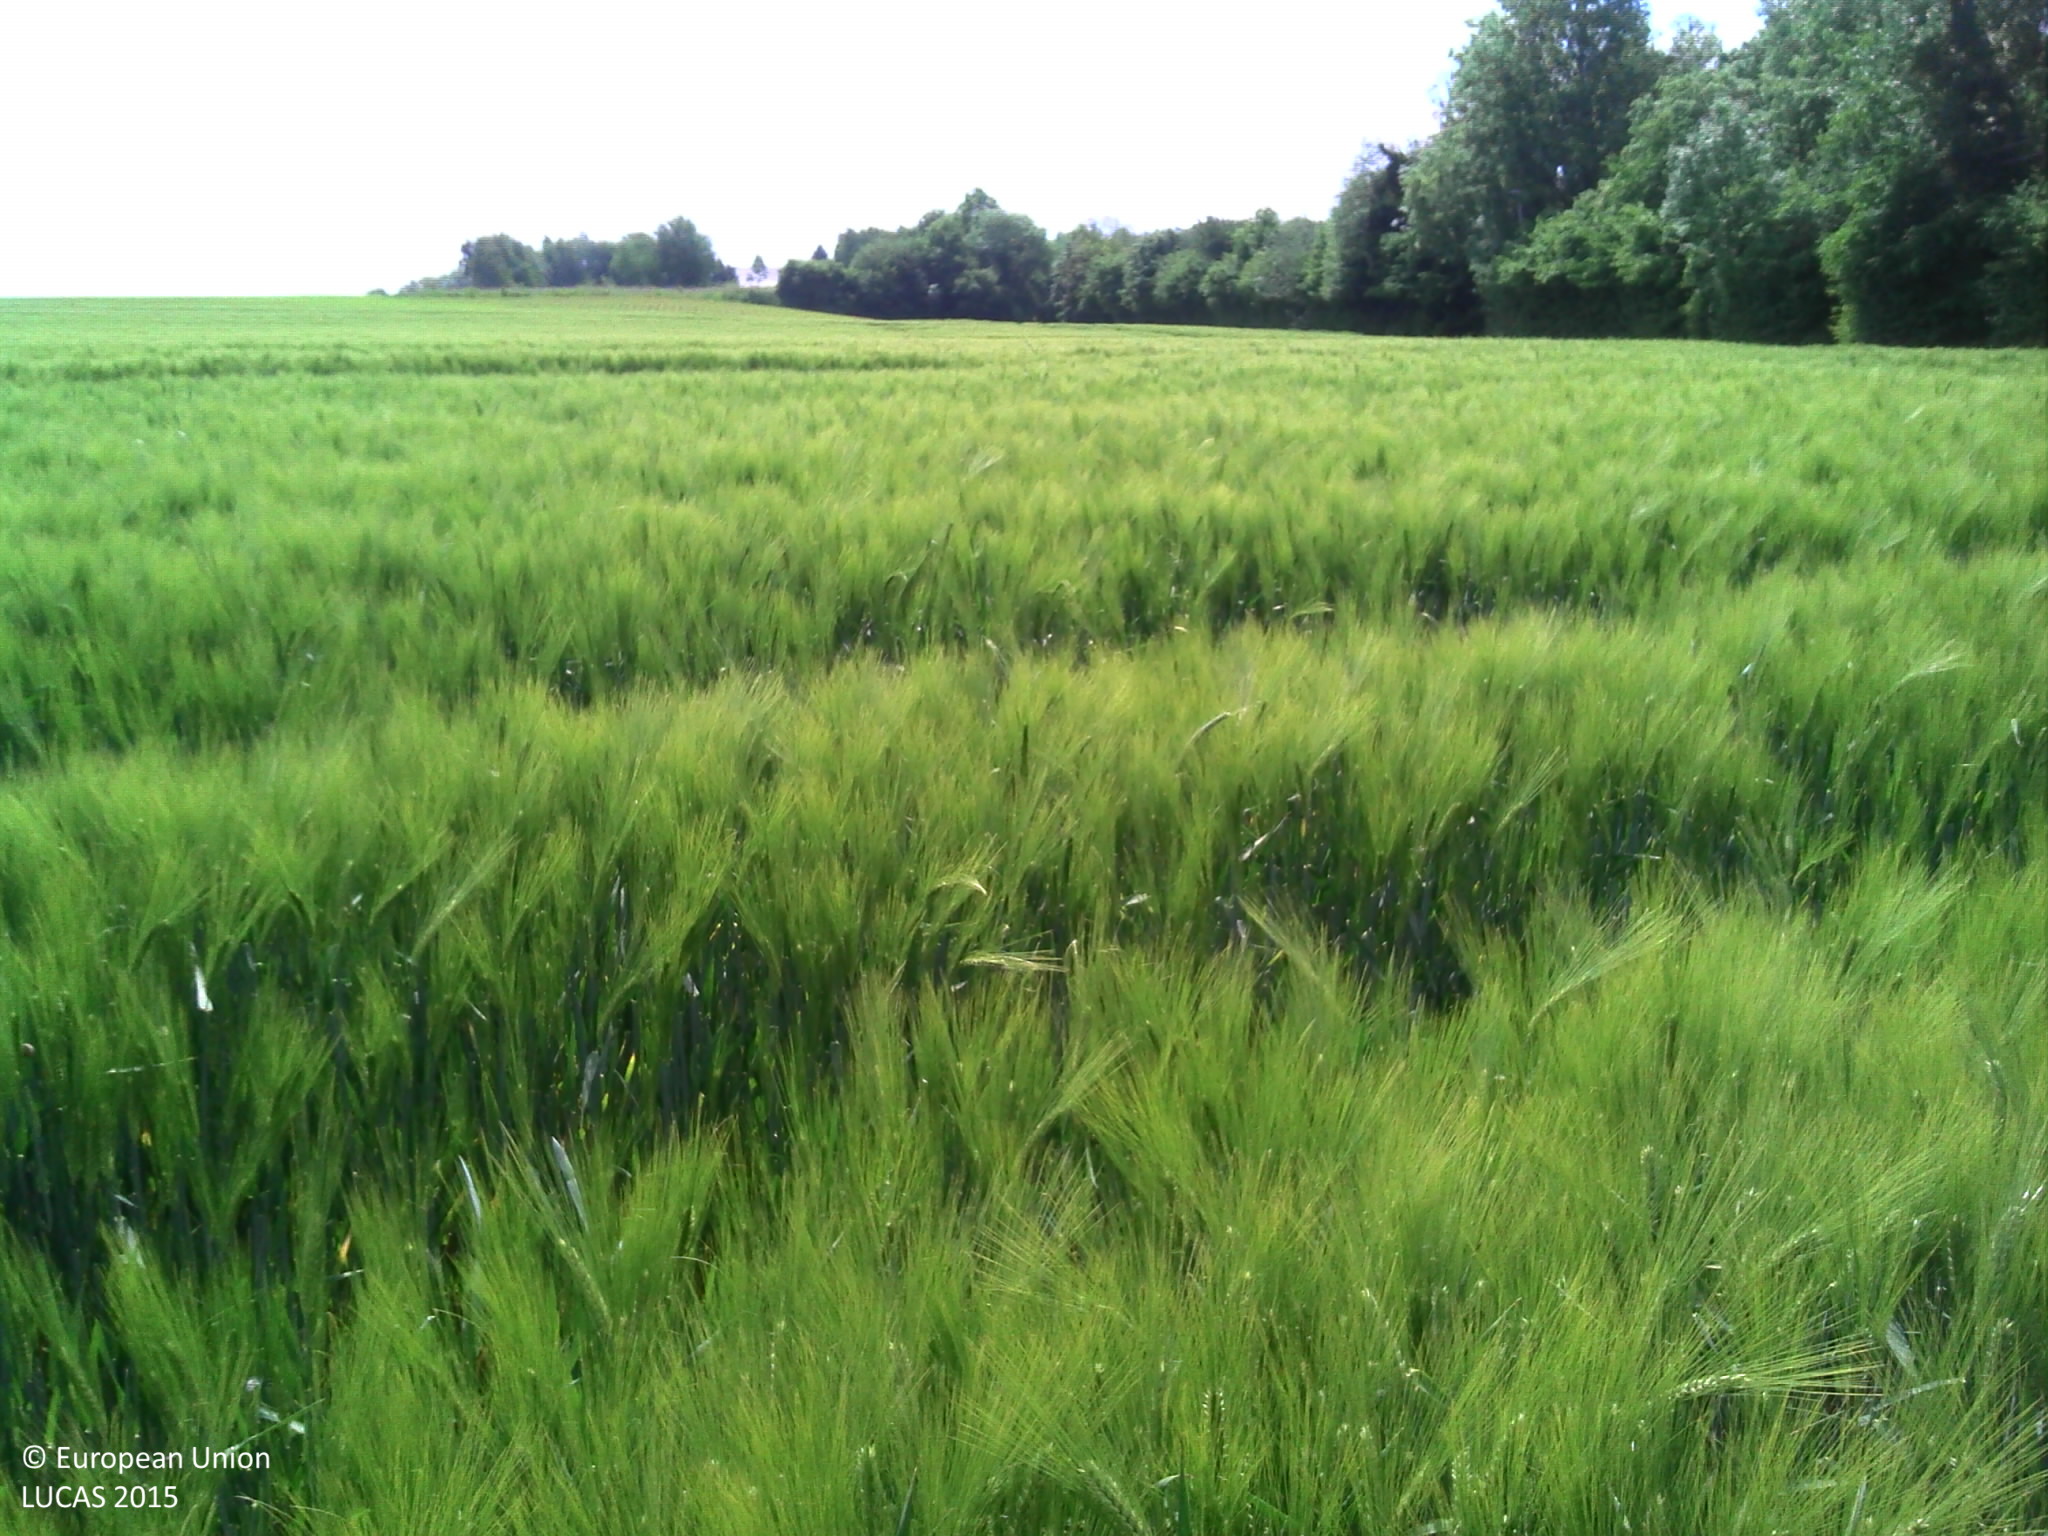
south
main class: Cropland
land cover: Barley
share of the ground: > 75 %
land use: Agriculture (excluding fallow land and kitchen gardens)
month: May
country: BE
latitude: 50.5909
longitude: 4.4726
